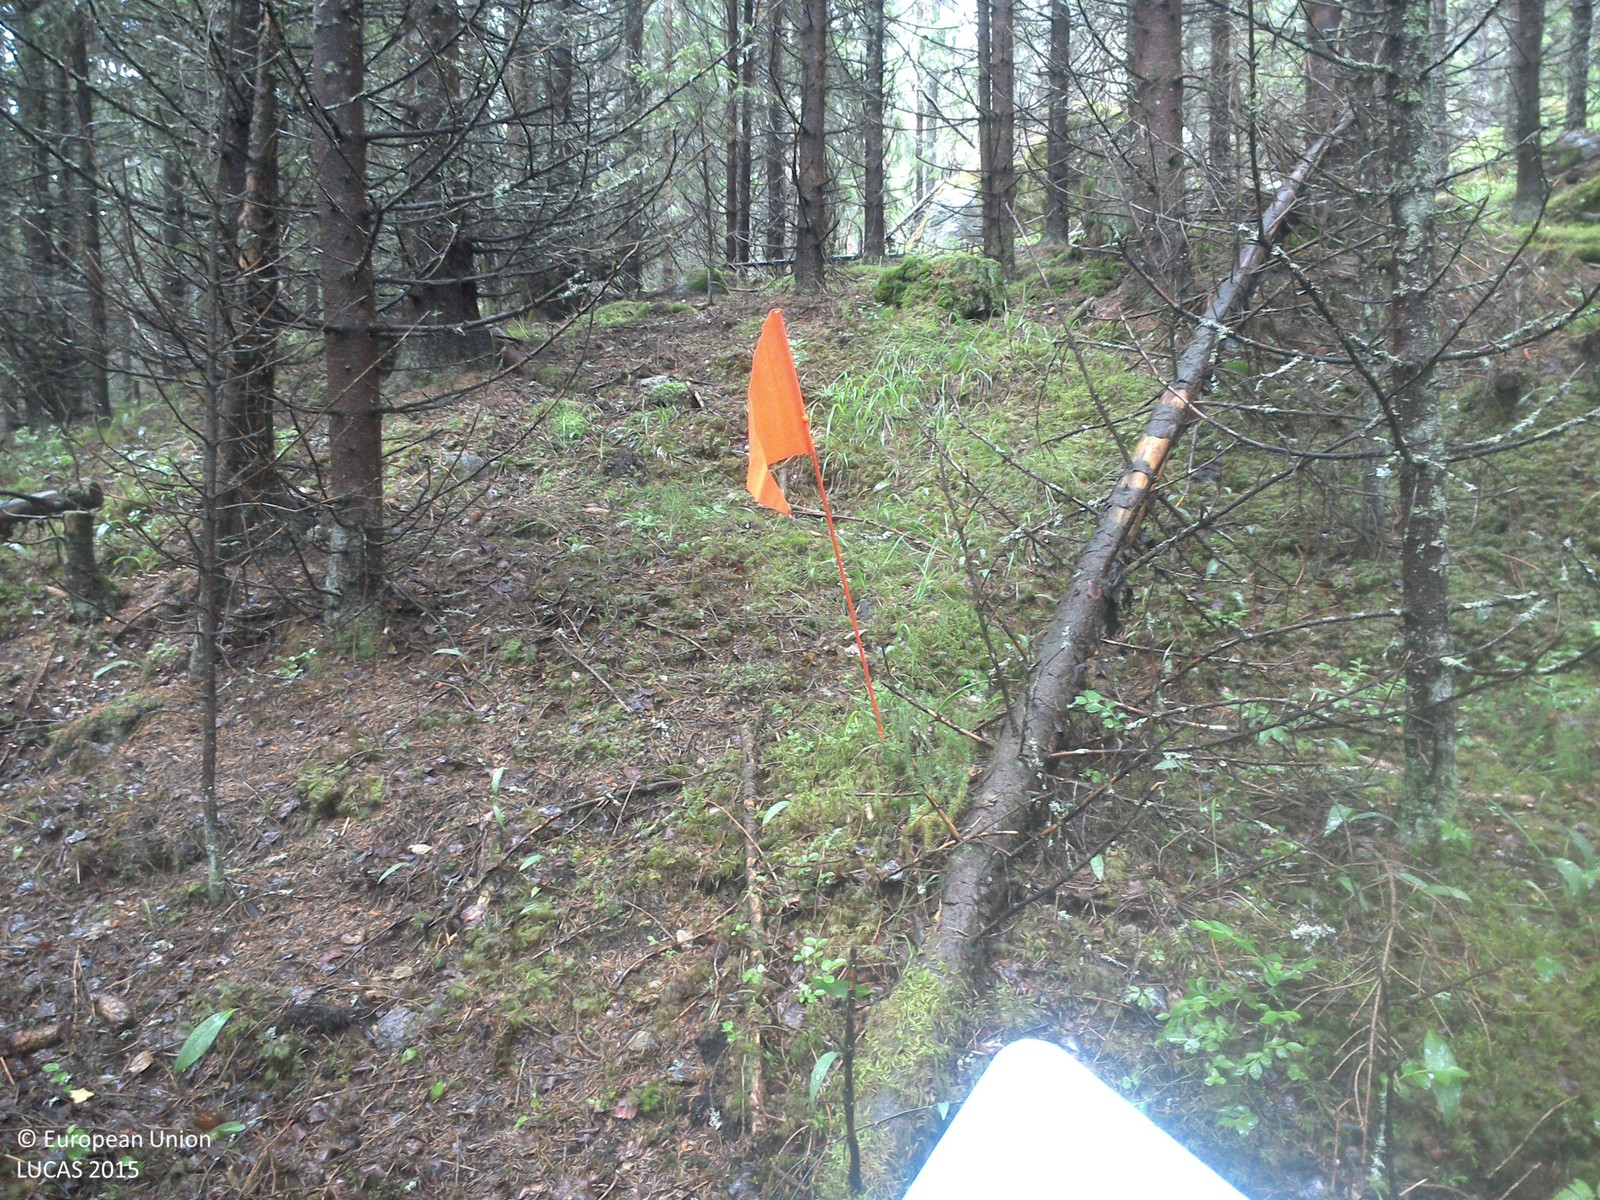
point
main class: Woodland
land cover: Spruce dominated coniferous woodland
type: boreal forest
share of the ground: > 75 %
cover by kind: coniferous forest trees 70 %, lichens and mosses 30 %
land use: Forestry
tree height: > 5 m
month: June
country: SE
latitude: 58.0505
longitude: 15.9772
